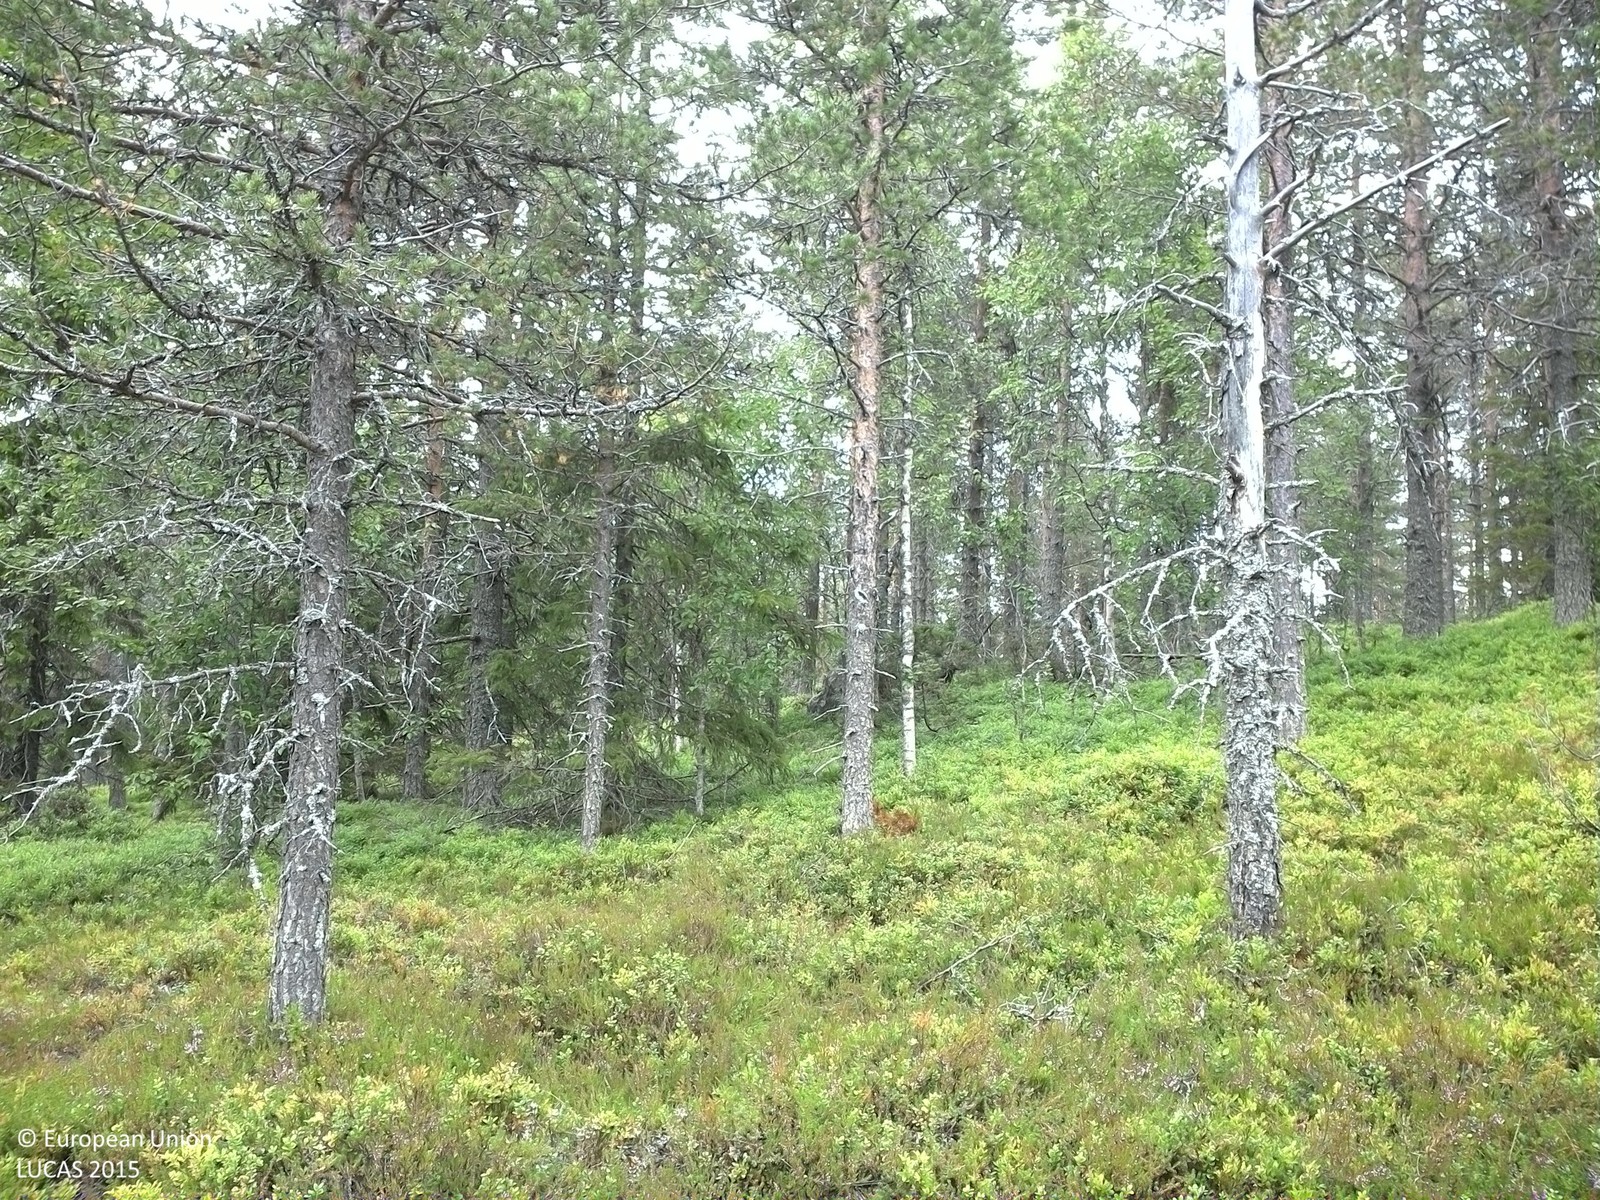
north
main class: Woodland
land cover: Pine dominated mixed woodland
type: boreal forest
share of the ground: 25 - 50 %
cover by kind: shrubs 50 %, coniferous forest trees 25 %, broadleaved forest trees 15 %, herbaceous plants 5 %, lichens and mosses 5 %
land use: Forestry
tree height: > 5 m
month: August
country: SE
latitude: 63.8351
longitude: 17.9605
